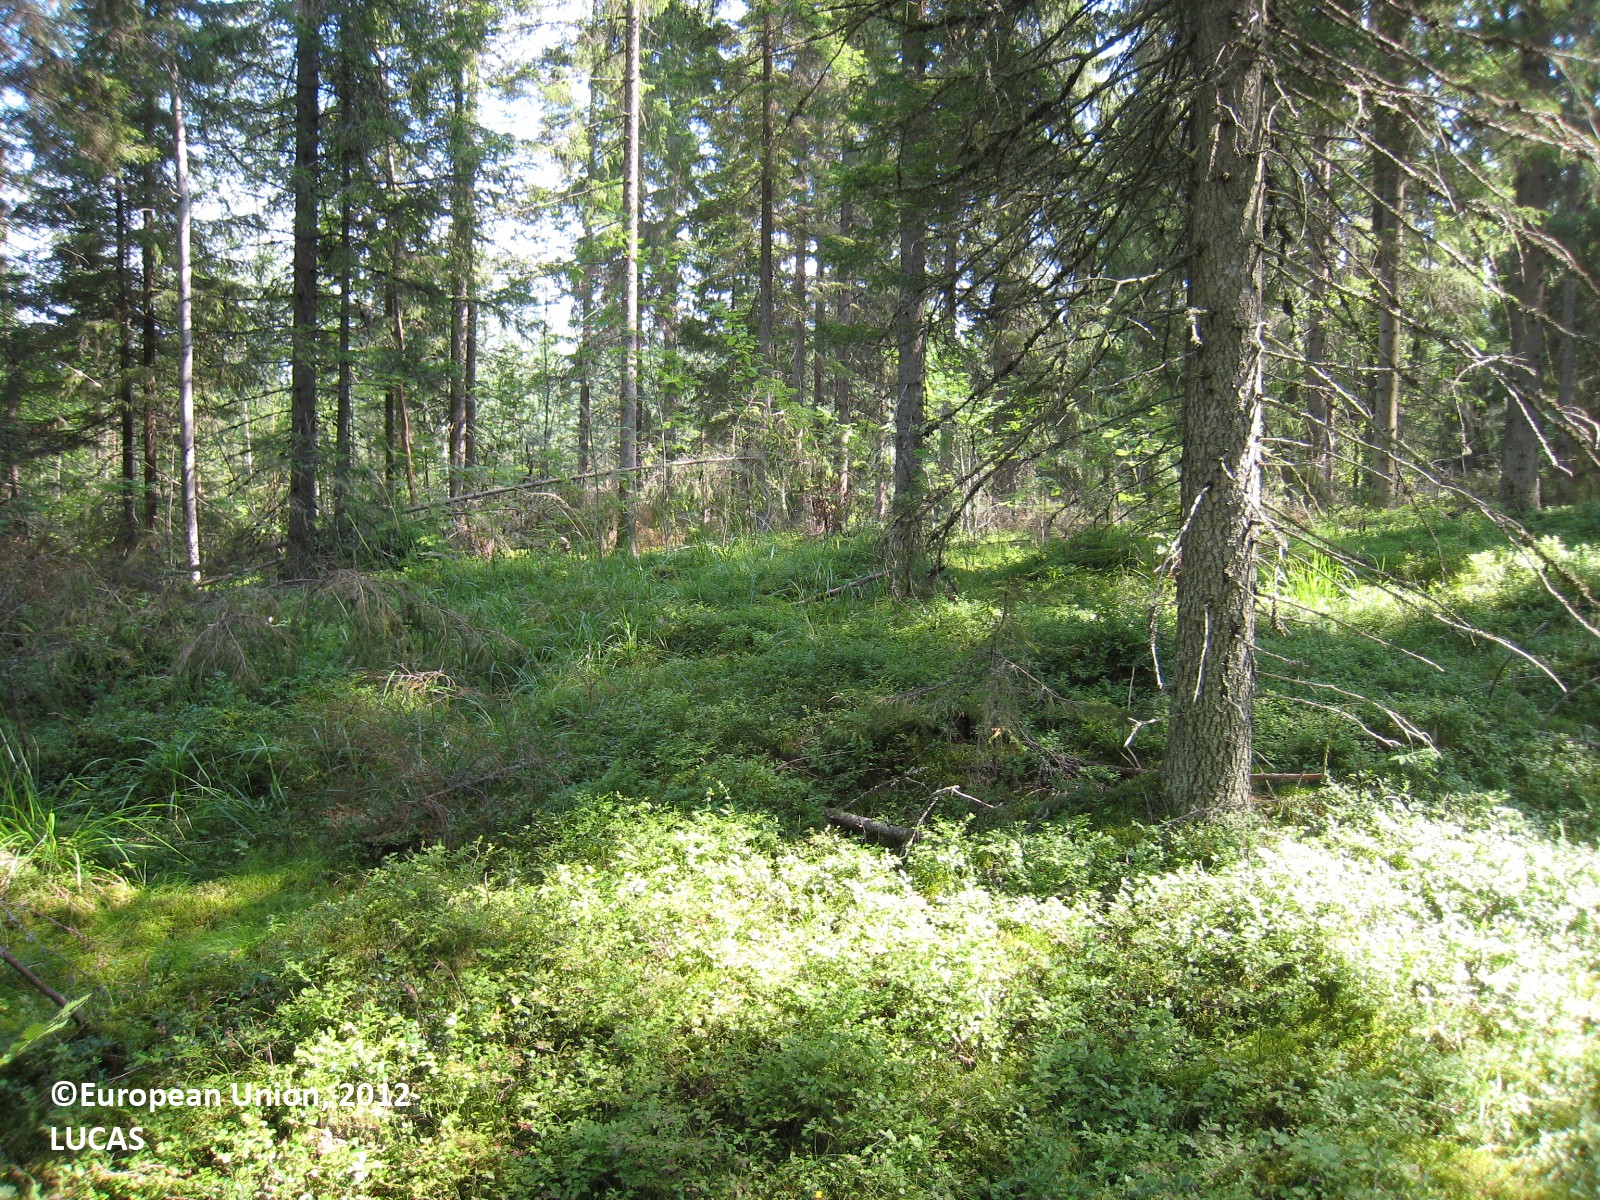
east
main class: Woodland
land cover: Spruce dominated coniferous woodland
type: boreal forest
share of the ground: 50 - 75 %
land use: Forestry
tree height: > 5 m
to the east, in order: Spruce dominated coniferous woodland; Pine dominated mixed woodland; Other mixed woodland; Pine dominated coniferous woodland; Ditches and canals; Pine dominated coniferous woodland; Other coniferous woodland
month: July
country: FI
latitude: 61.7901
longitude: 26.1205
